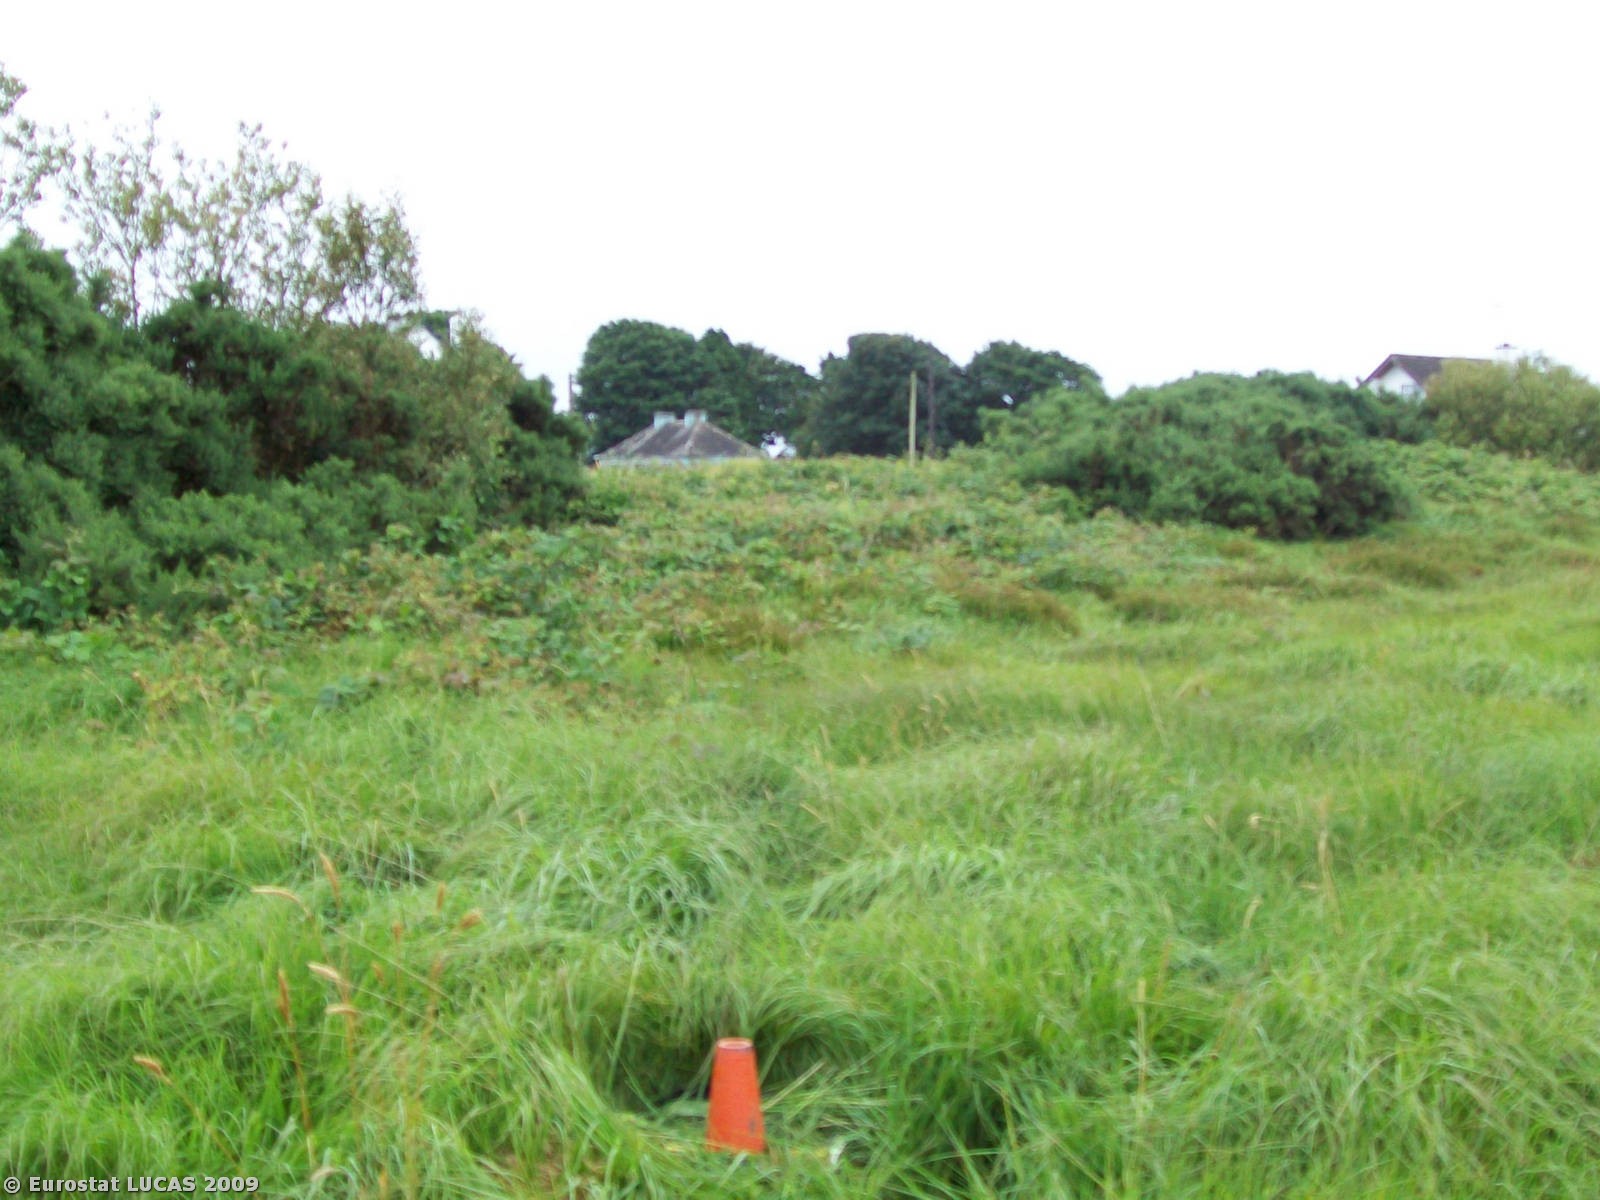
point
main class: Grassland
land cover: Grassland without tree/shrub cover
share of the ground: > 75 %
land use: Agriculture (excluding fallow land and kitchen gardens)
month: July
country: IE
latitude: 53.6474
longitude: -8.9225
